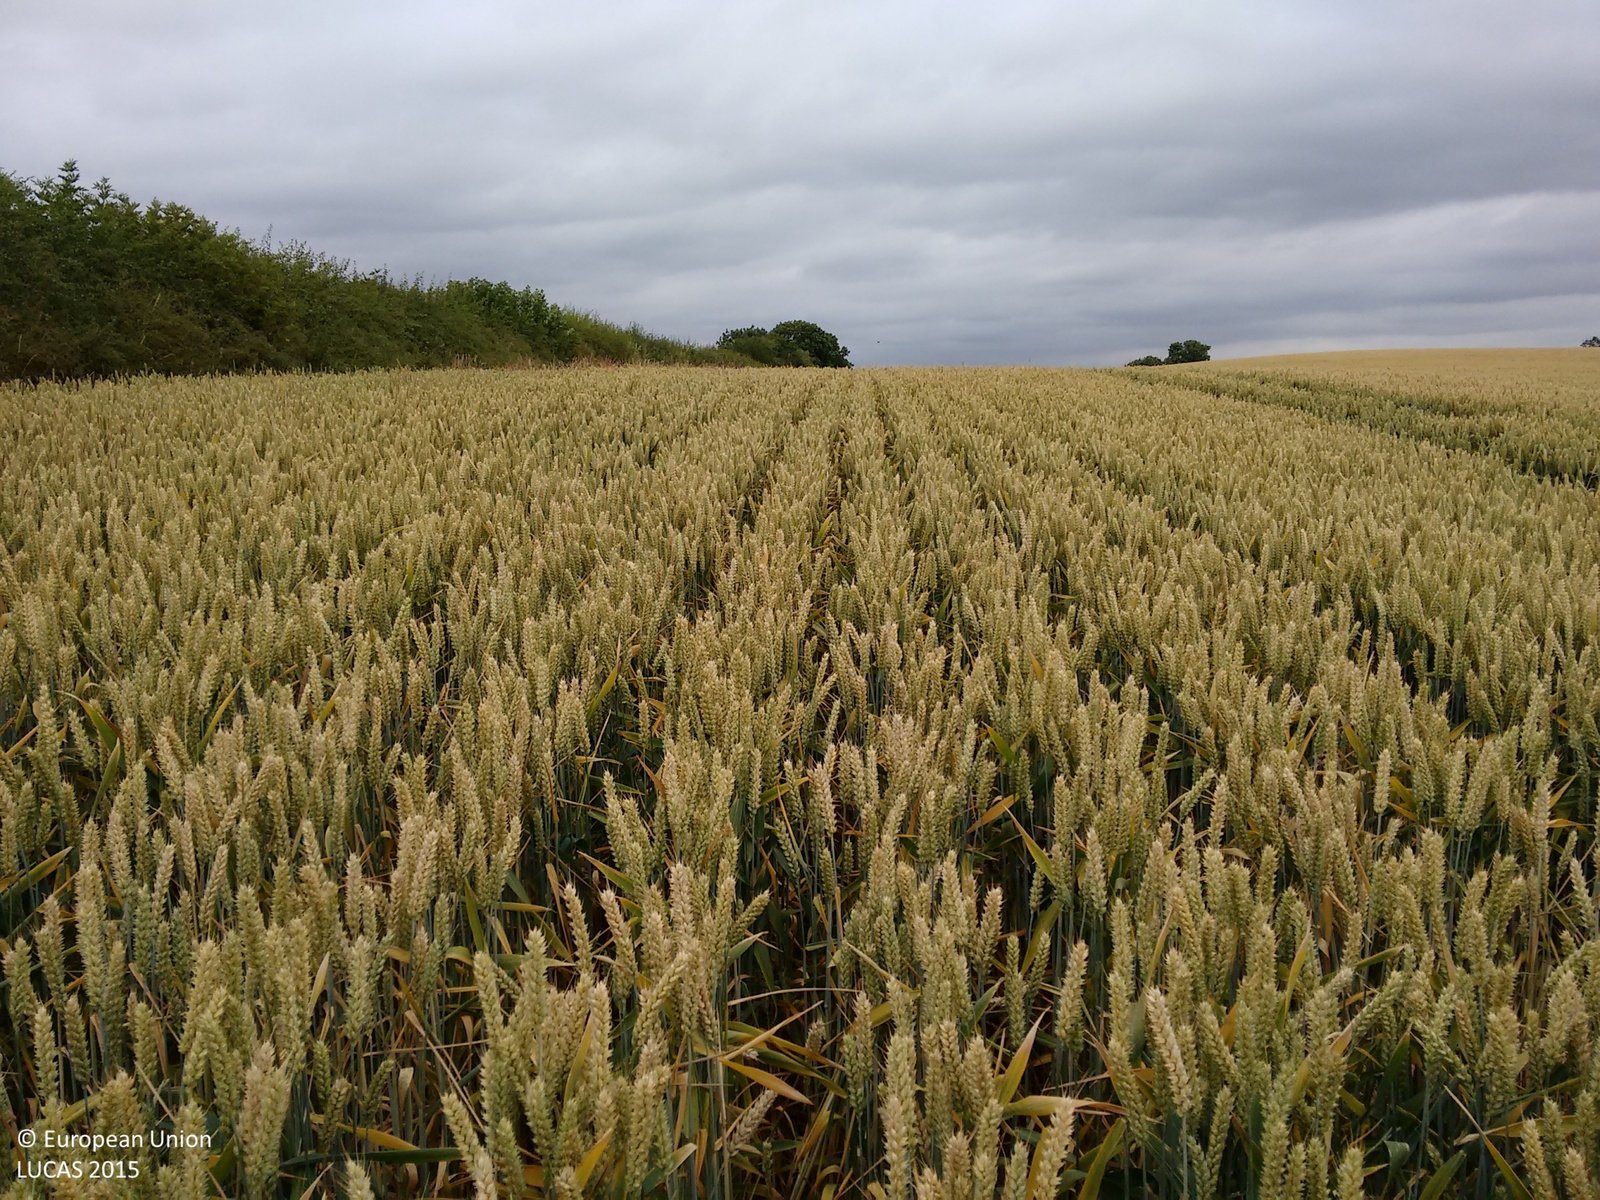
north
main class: Cropland
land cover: Common wheat
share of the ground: > 75 %
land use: Agriculture (excluding fallow land and kitchen gardens)
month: July
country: GB
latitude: 52.4530
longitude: -0.9176
